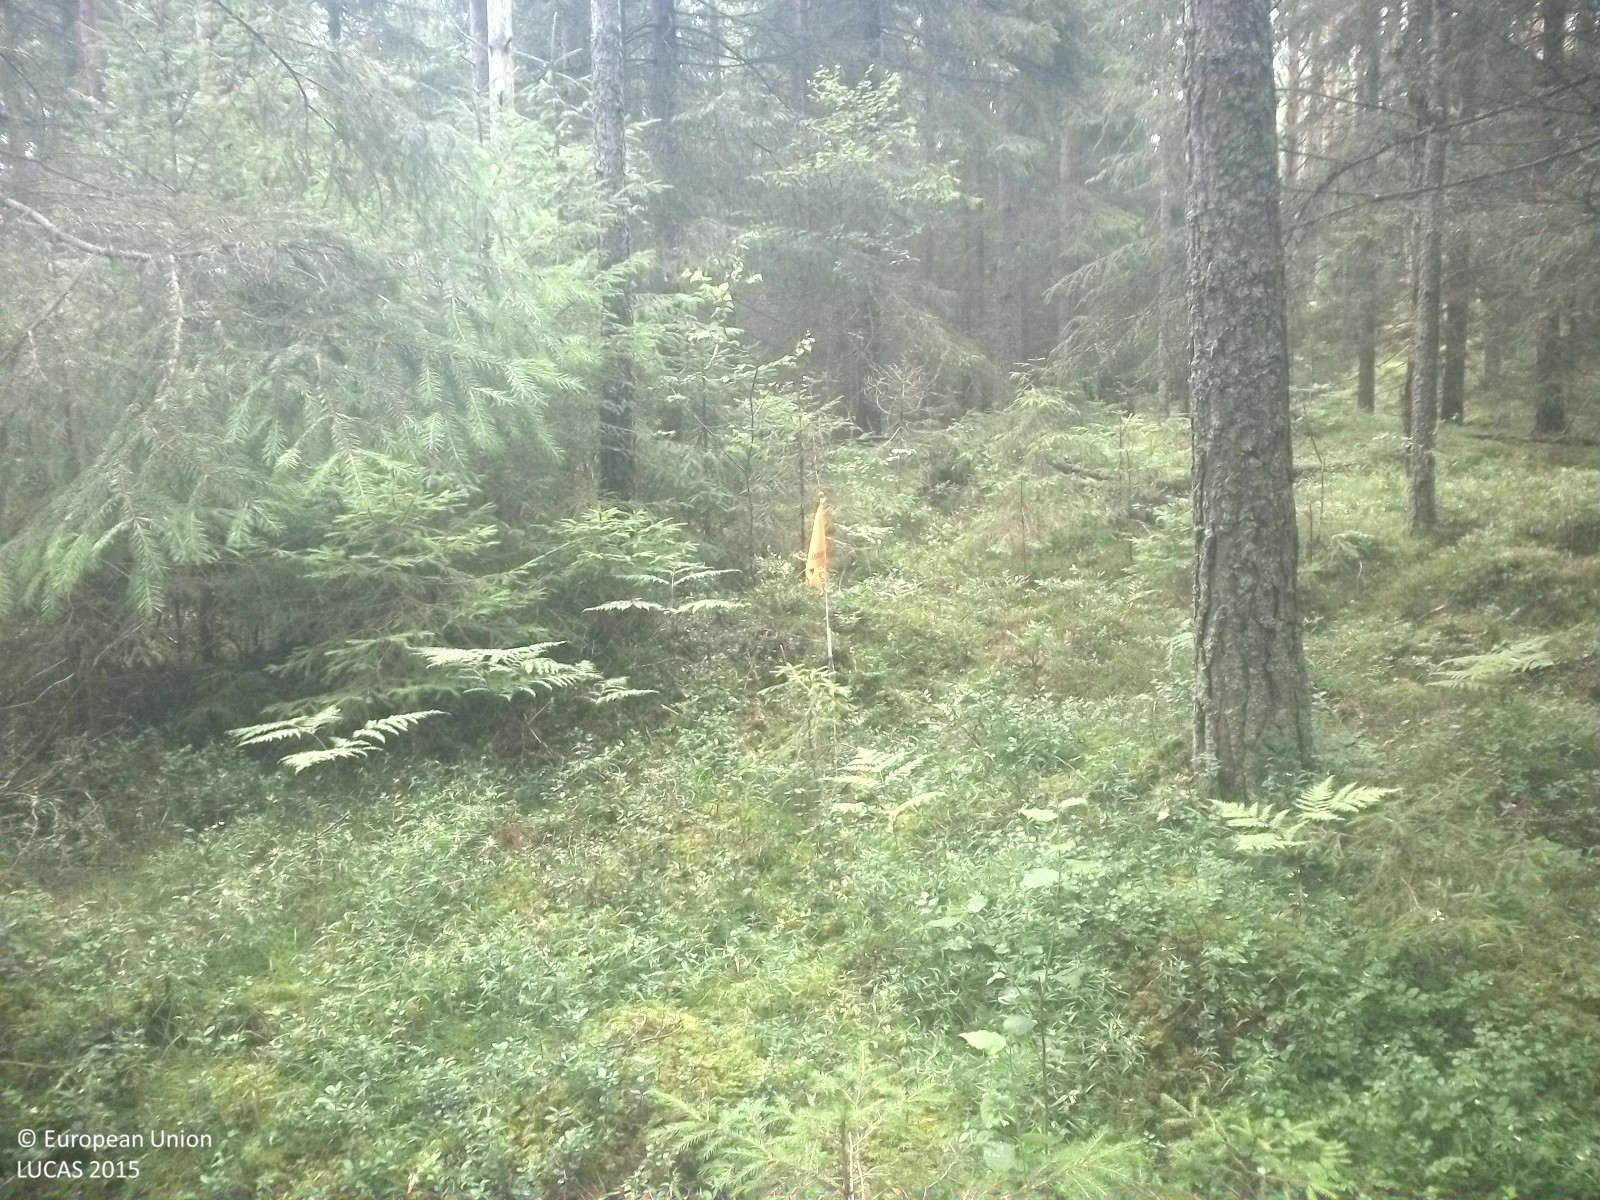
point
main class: Woodland
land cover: Other mixed woodland
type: boreal forest
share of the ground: 25 - 50 %
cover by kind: herbaceous plants 25 %, lichens and mosses 25 %, coniferous forest trees 20 %, broadleaved forest trees 20 %, shrubs 10 %
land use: Forestry
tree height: > 5 m
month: July
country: SE
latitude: 58.9194
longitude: 15.0116
